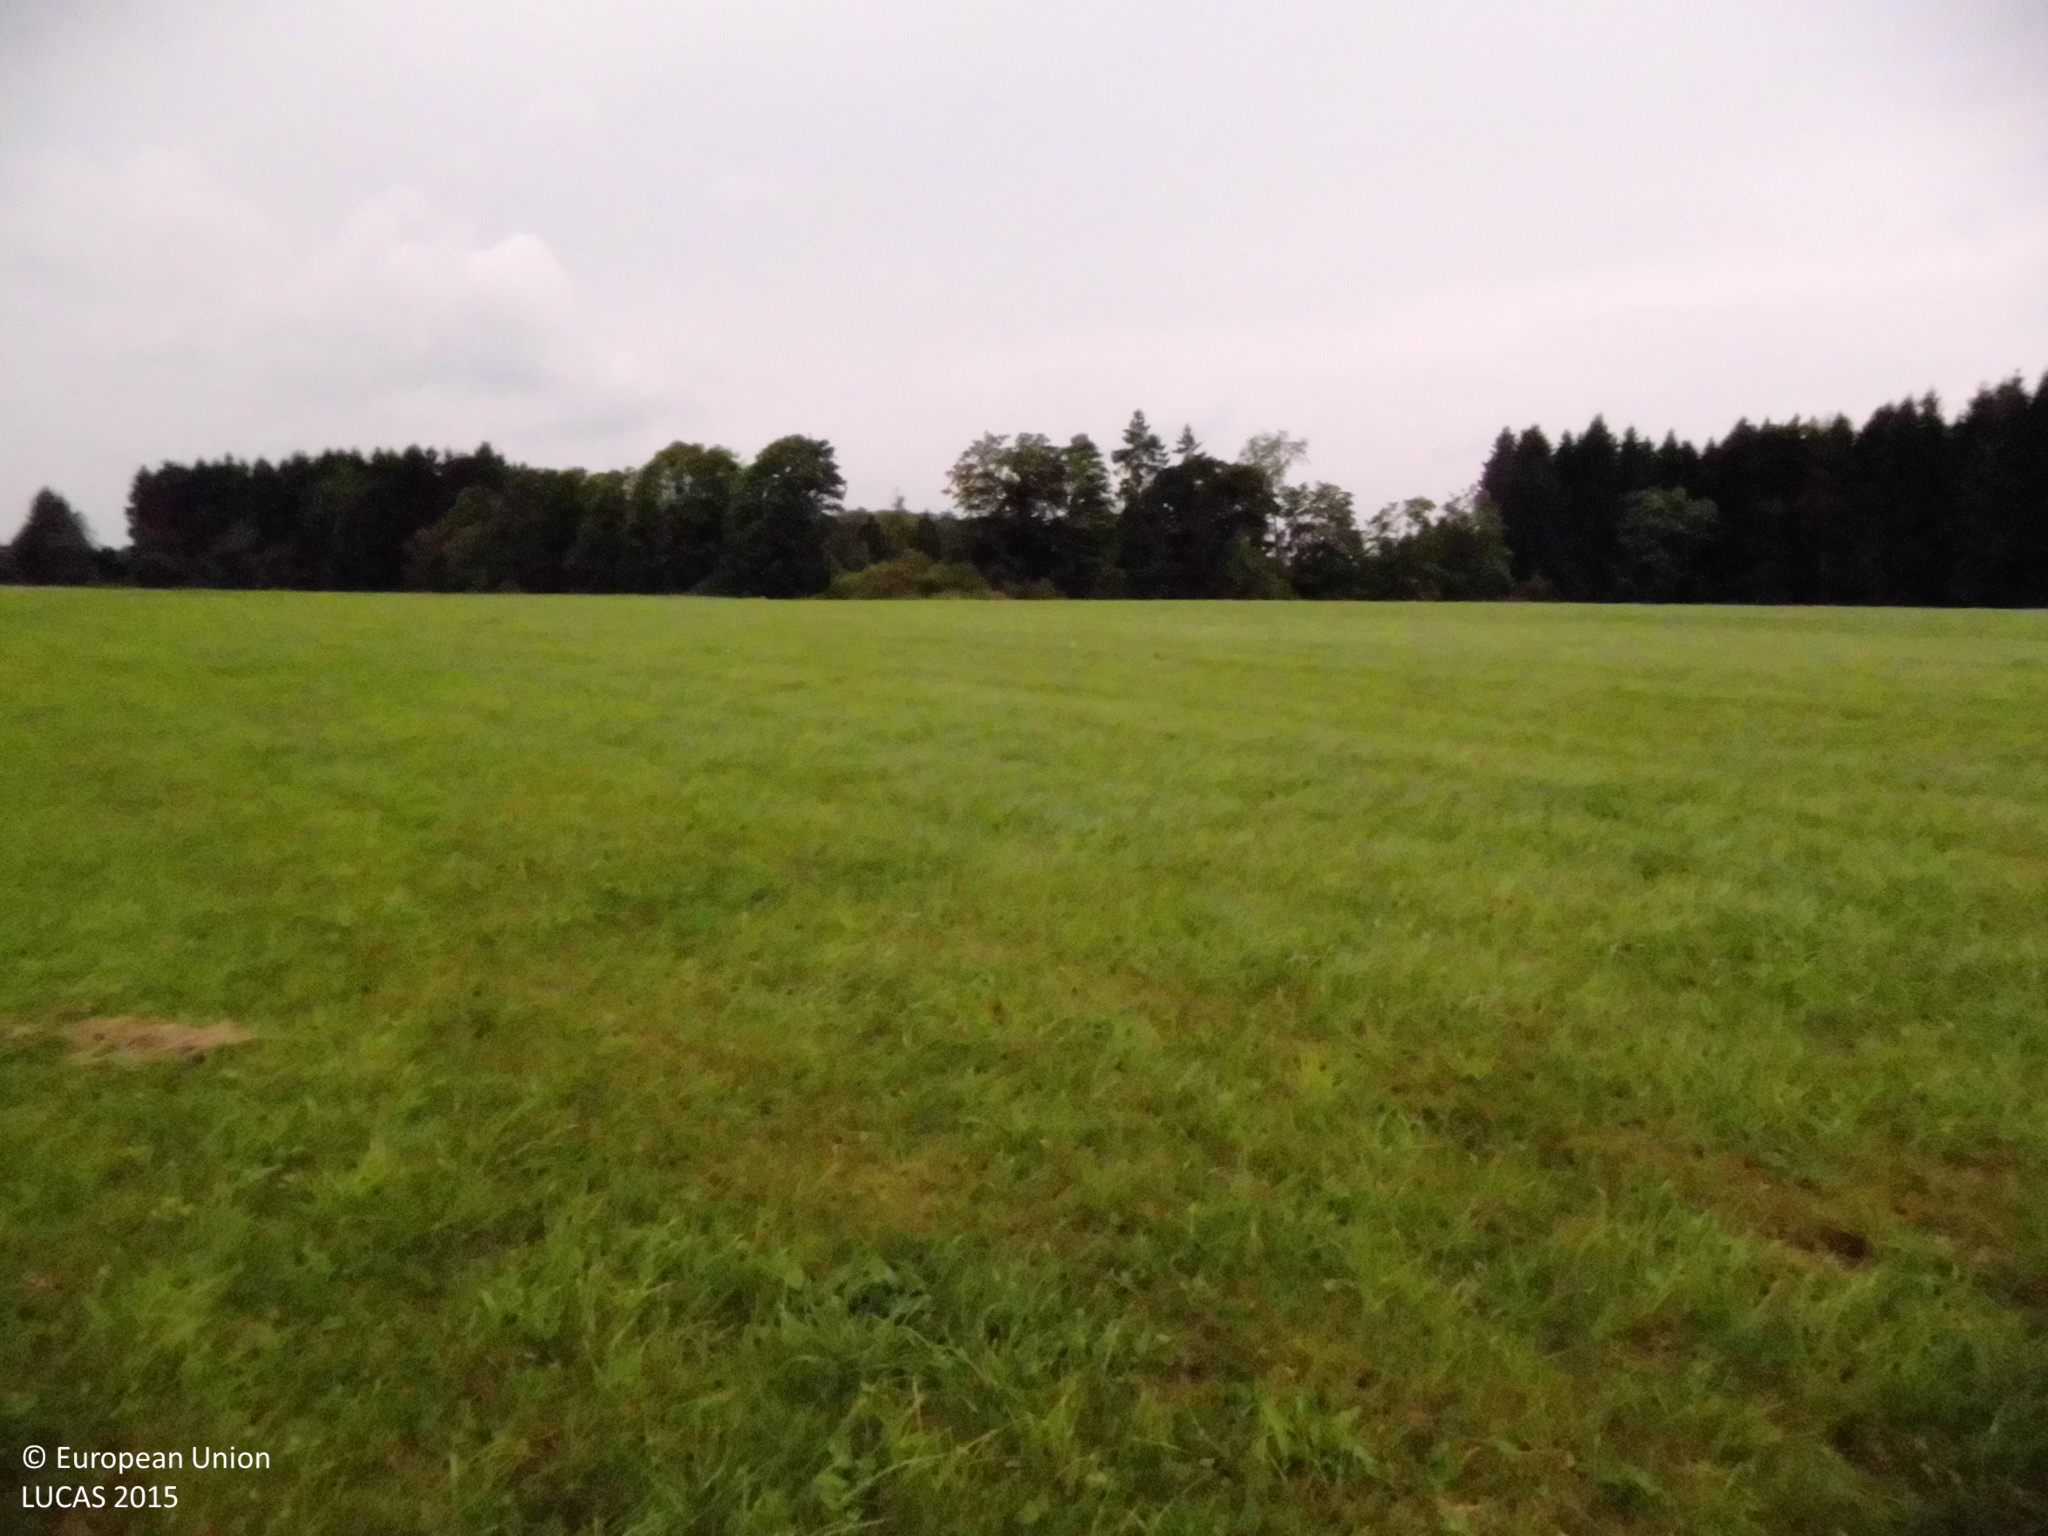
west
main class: Grassland
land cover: Grassland without tree/shrub cover
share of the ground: > 75 %
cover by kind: herbaceous plants 100 %
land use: Agriculture (excluding fallow land and kitchen gardens)
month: August
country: DE
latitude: 50.6704
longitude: 8.0053
